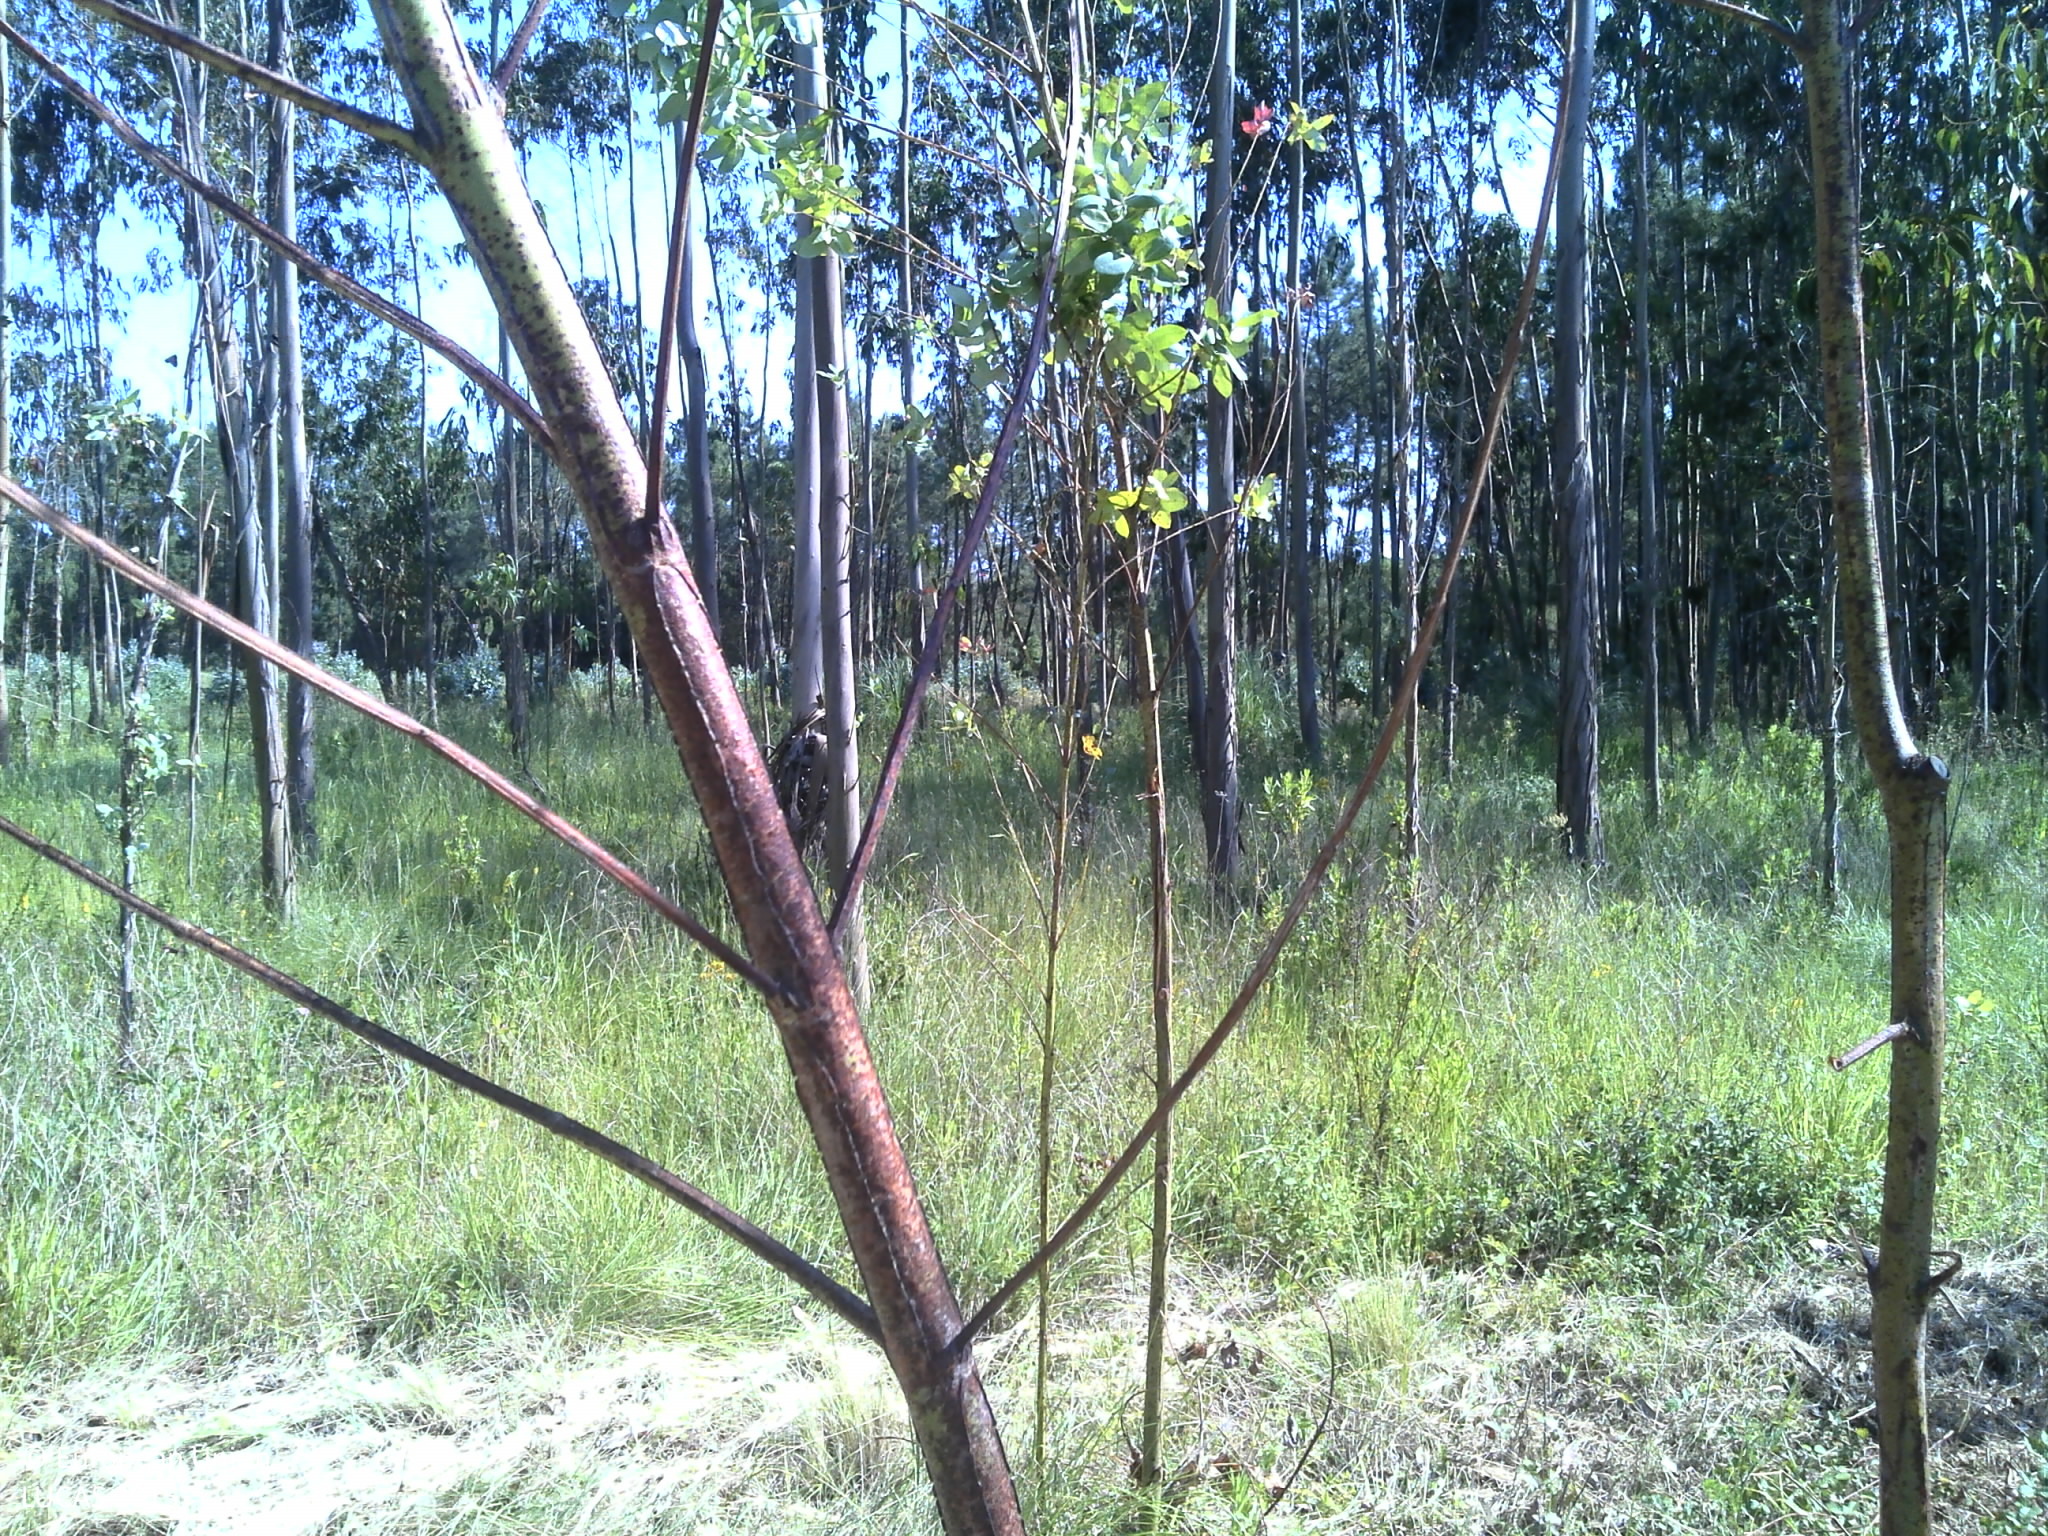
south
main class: Woodland
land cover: Broadleaved woodland
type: exotic forest
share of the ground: 25 - 50 %
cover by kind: broadleaved forest trees 50 %, unconsolidated bare surface 35 %, herbaceous plants 10 %, shrubs 5 %
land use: Forestry
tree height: < 5 m
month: June
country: PT
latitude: 40.3558
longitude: -8.6129
